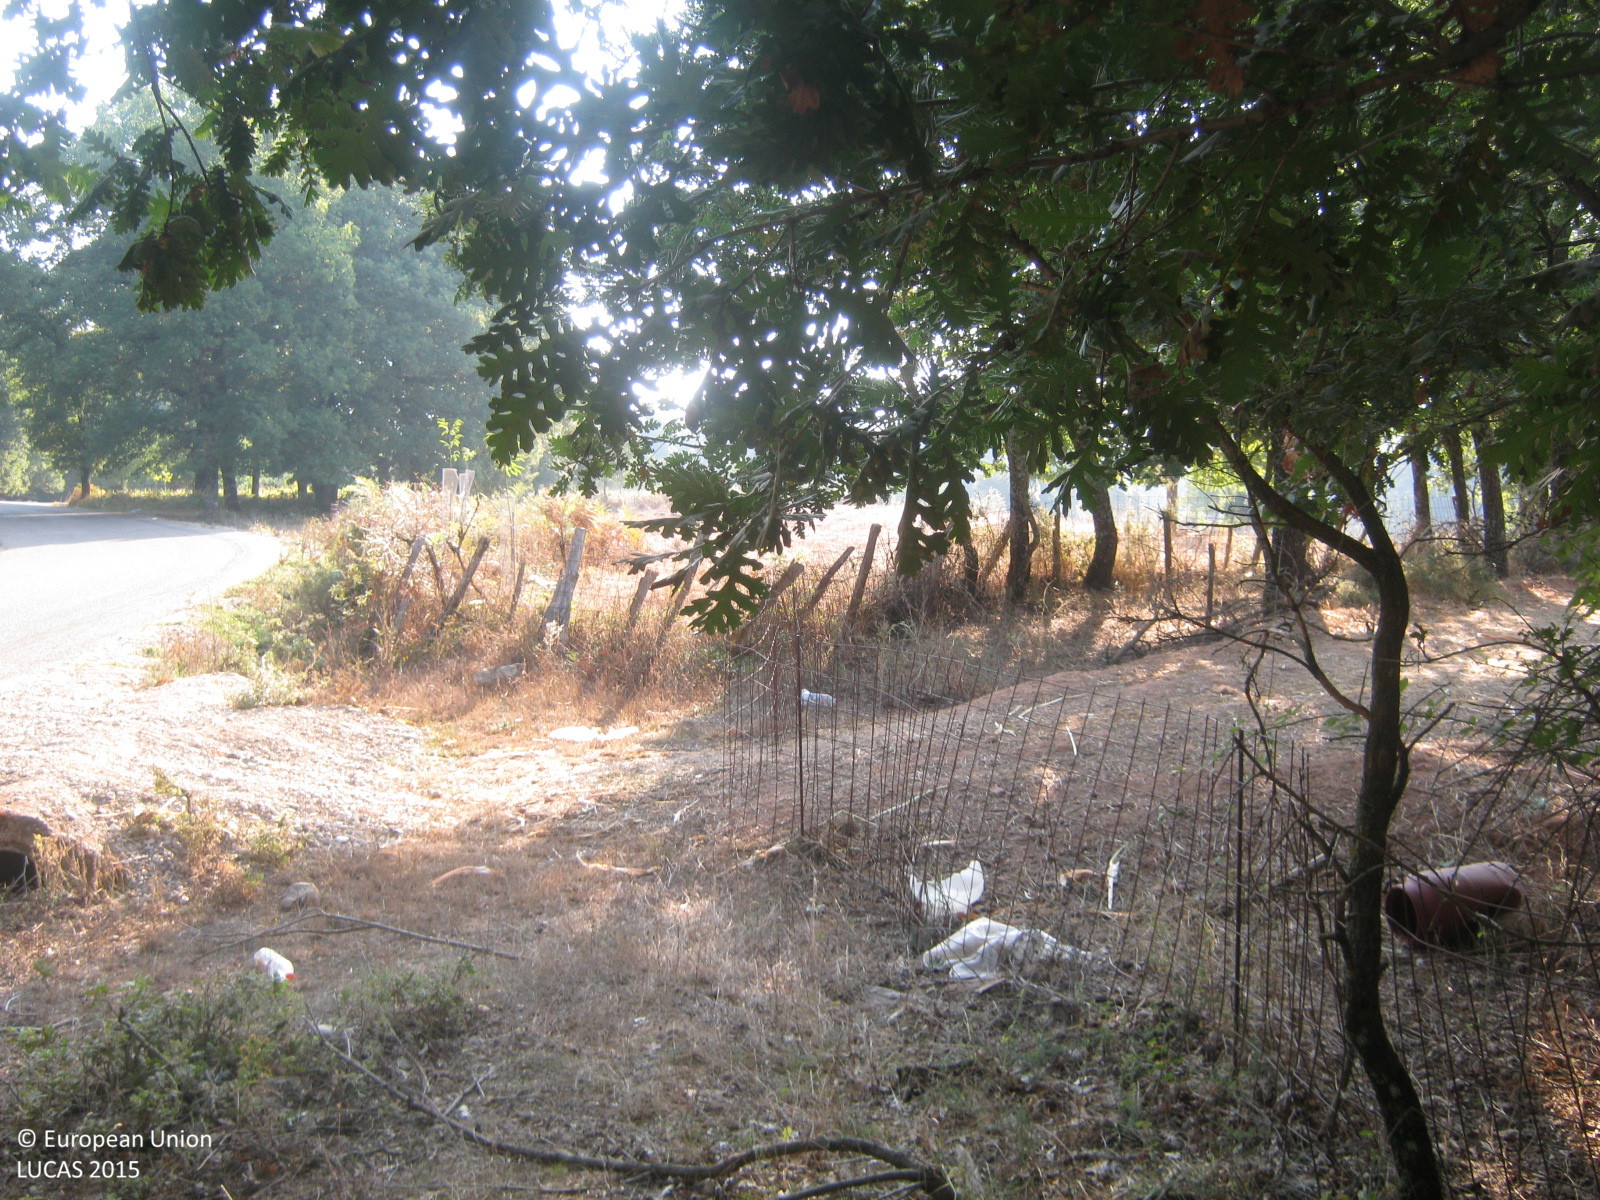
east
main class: Woodland
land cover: Broadleaved woodland
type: broadleaved evergreen forest
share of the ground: > 75 %
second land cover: Spontaneously vegetated surfaces
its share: 10 - 25 %
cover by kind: broadleaved forest trees 90 %, herbaceous plants 5 %, consolidated bare surface 5 %
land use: Forestry
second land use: Agriculture (excluding fallow land and kitchen gardens)
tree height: > 5 m
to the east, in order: Broadleaved woodland; Spontaneously vegetated surfaces; Fences; Other bare soil; Broadleaved woodland; Fences; Spontaneously vegetated surfaces; Electric lines; Spontaneously vegetated surfaces; Abandoned hedges; Fences; Maize; Olive groves; Fences; Spontaneously vegetated surfaces; Single bushes/trees; Spontaneously vegetated surfaces
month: September
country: GR
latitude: 37.7869
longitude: 21.7369
